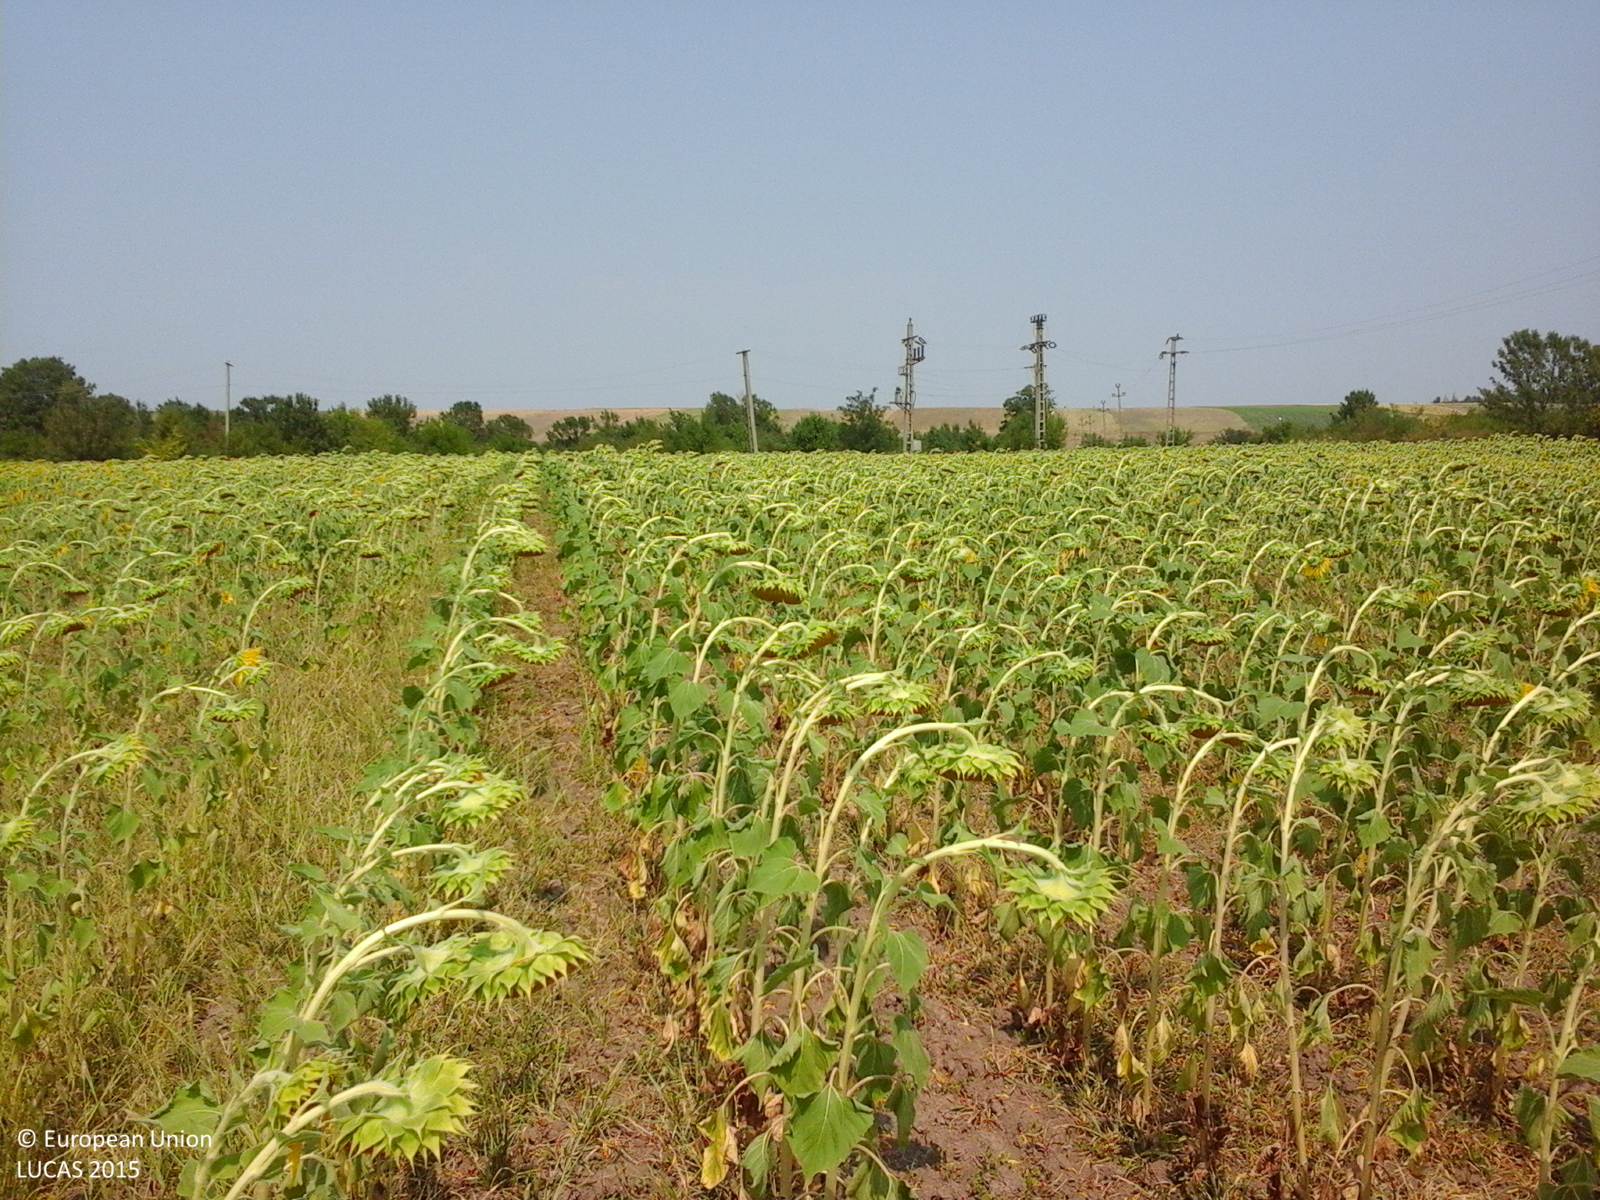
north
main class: Cropland
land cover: Sunflower
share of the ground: 50 - 75 %
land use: Agriculture (excluding fallow land and kitchen gardens)
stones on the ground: < 10 %
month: August
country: RO
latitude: 44.3326
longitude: 23.5597
